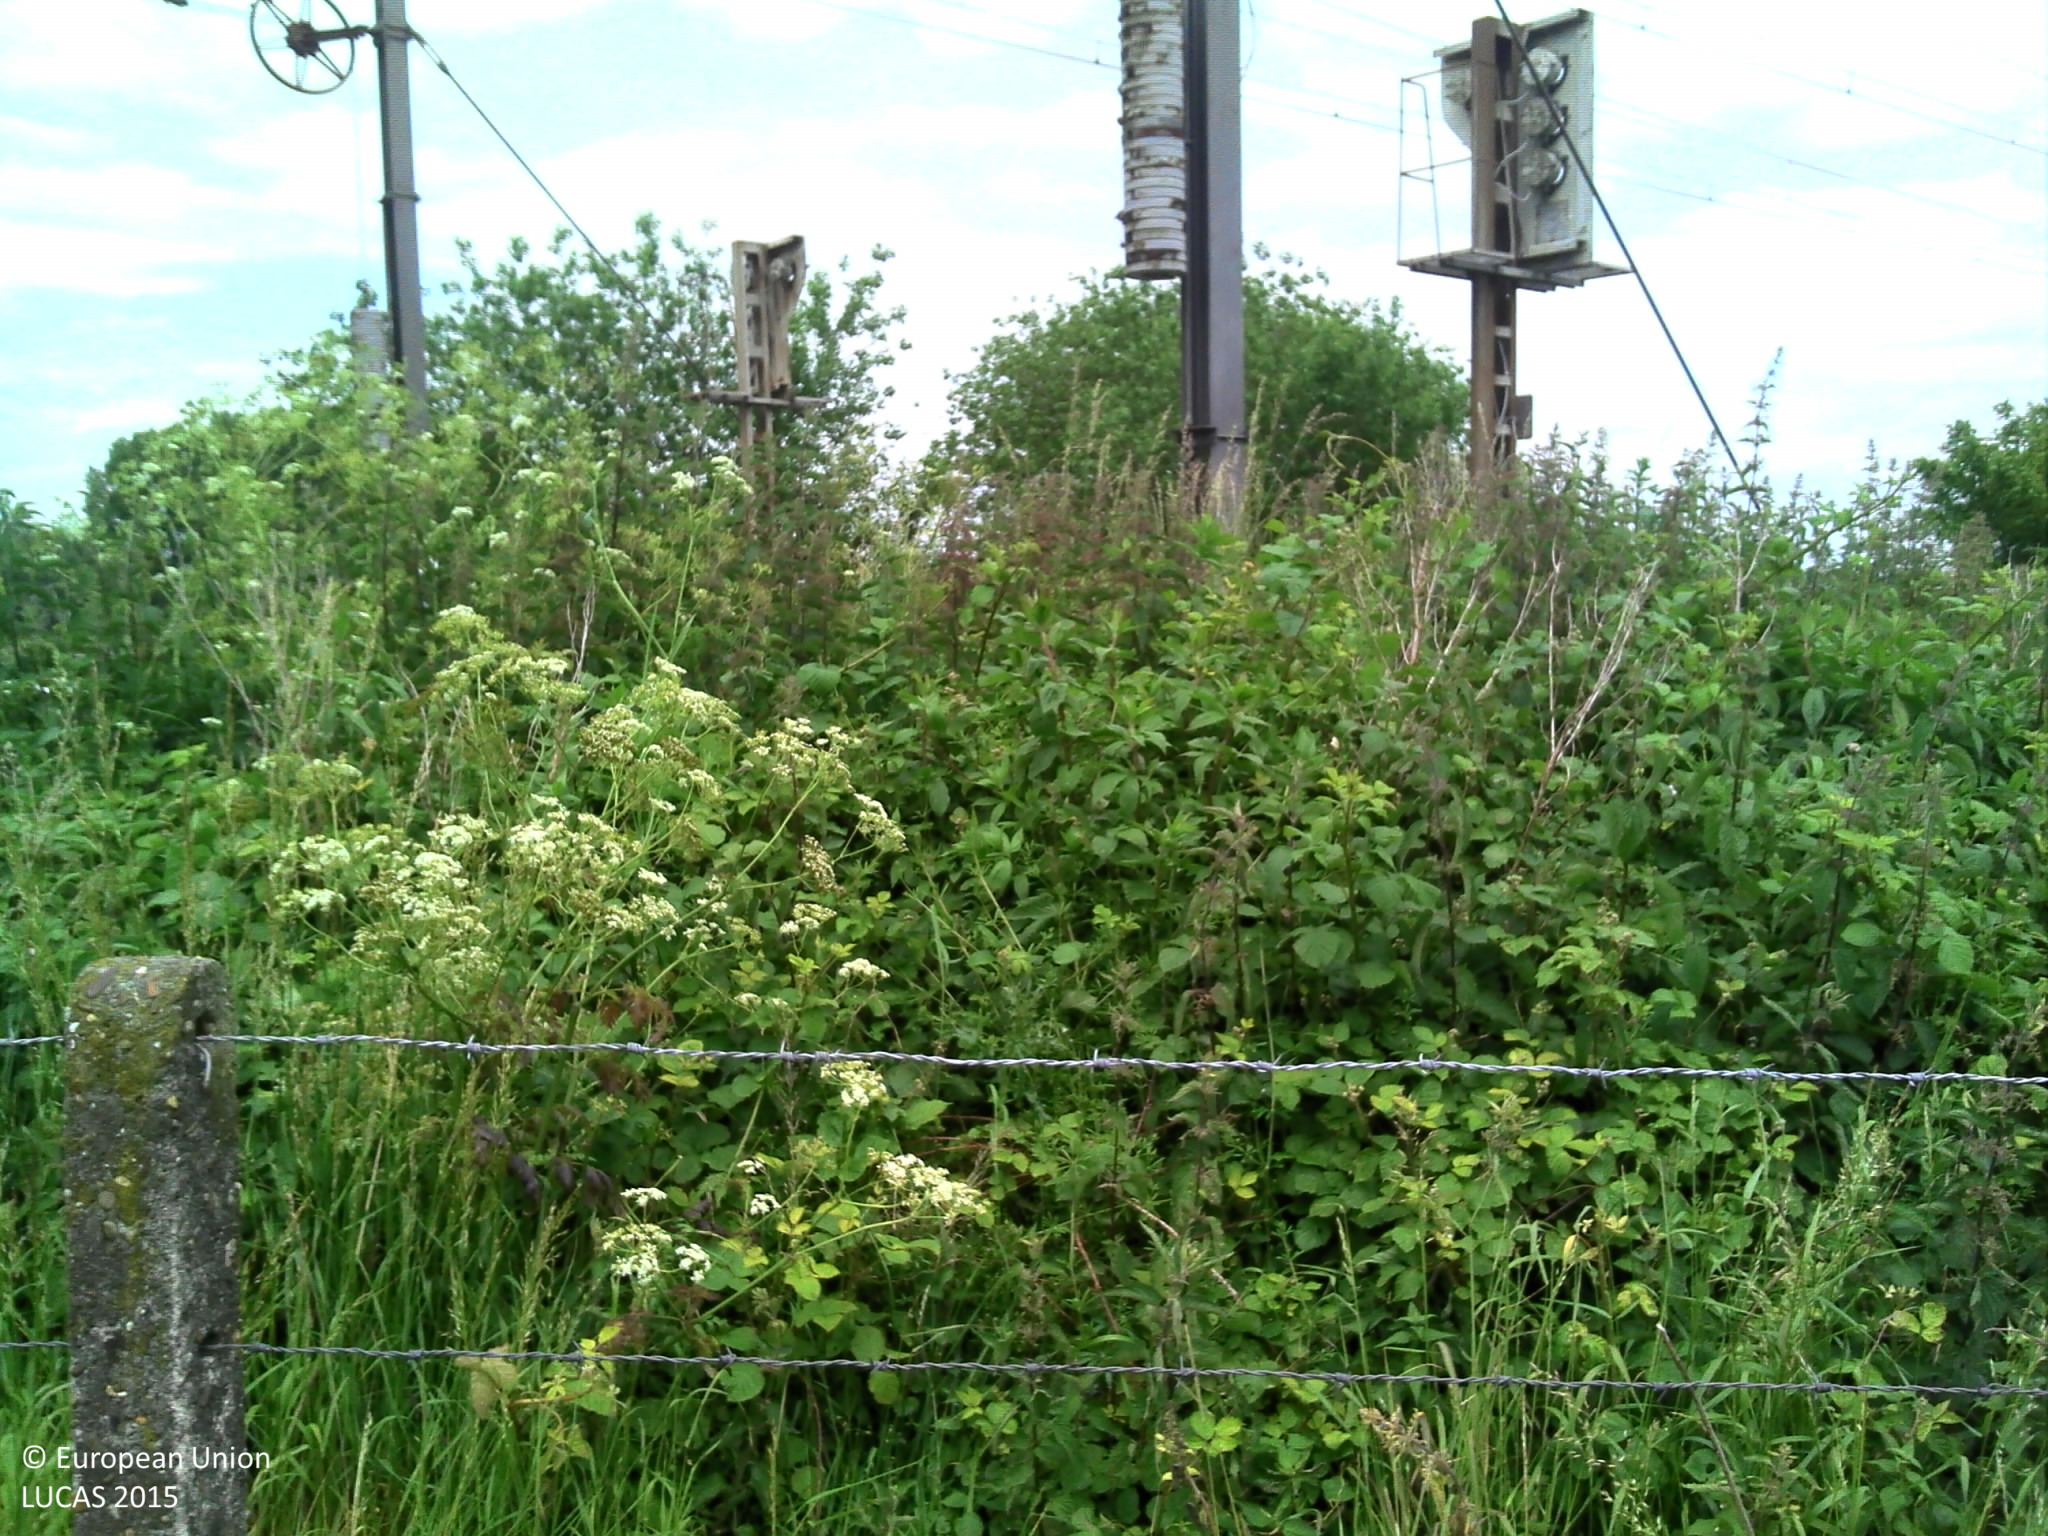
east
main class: Grassland
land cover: Grassland without tree/shrub cover
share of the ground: > 75 %
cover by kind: herbaceous plants 100 %
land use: Agriculture (excluding fallow land and kitchen gardens)
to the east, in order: Grassland without tree/shrub cover; Fences; Abandoned hedges; Electric lines; Railways; Electric lines; Grass margins; Abandoned hedges; Grass margins; Paved roads, cycling and walking lanes; Grass margins; Fences; Grassland without tree/shrub cover; Fences; Maize
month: June
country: BE
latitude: 50.9101
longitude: 4.0066
